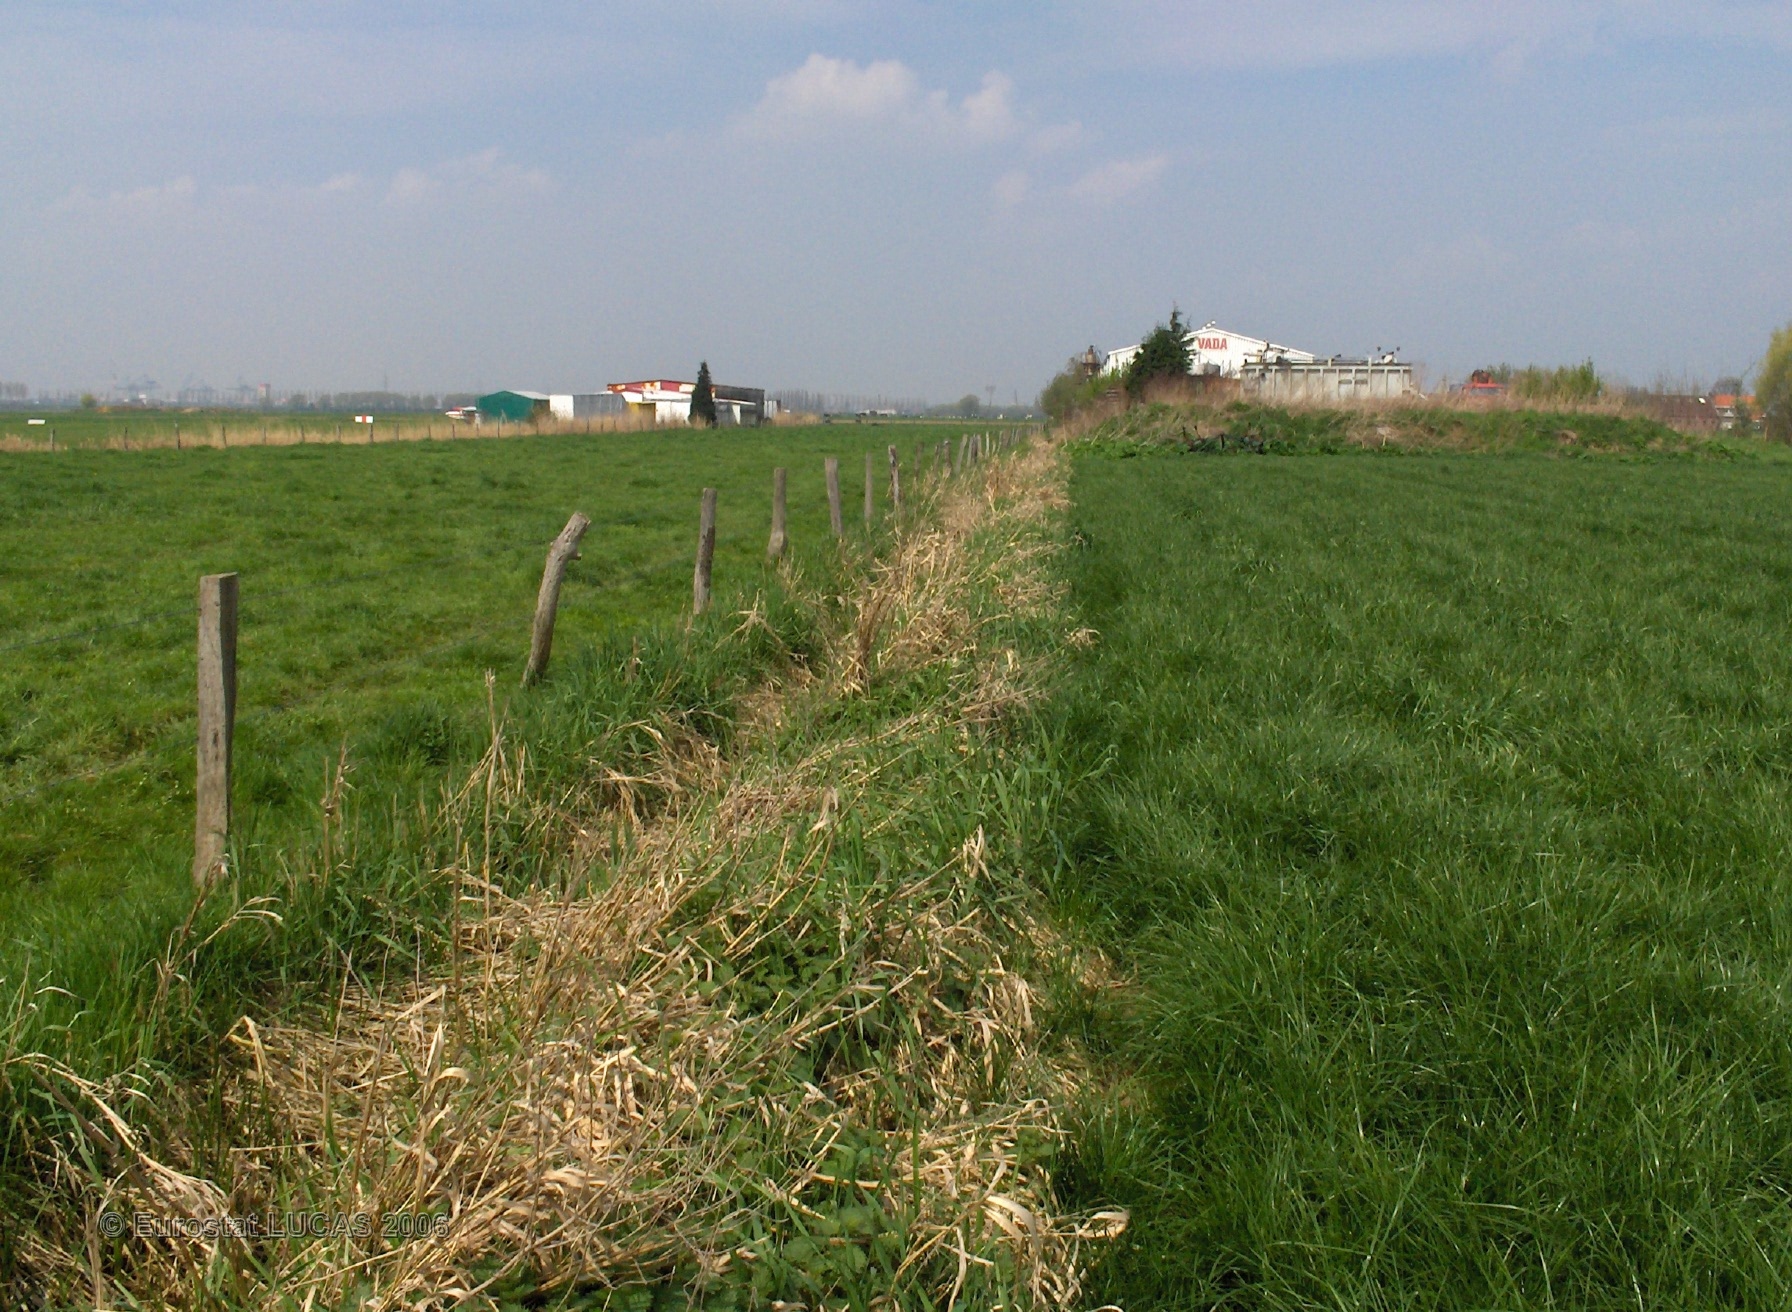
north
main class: Grassland
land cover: Grassland without tree/shrub cover
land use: Agriculture (excluding fallow land and kitchen gardens)
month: April
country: BE
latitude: 51.3077
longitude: 4.3865
